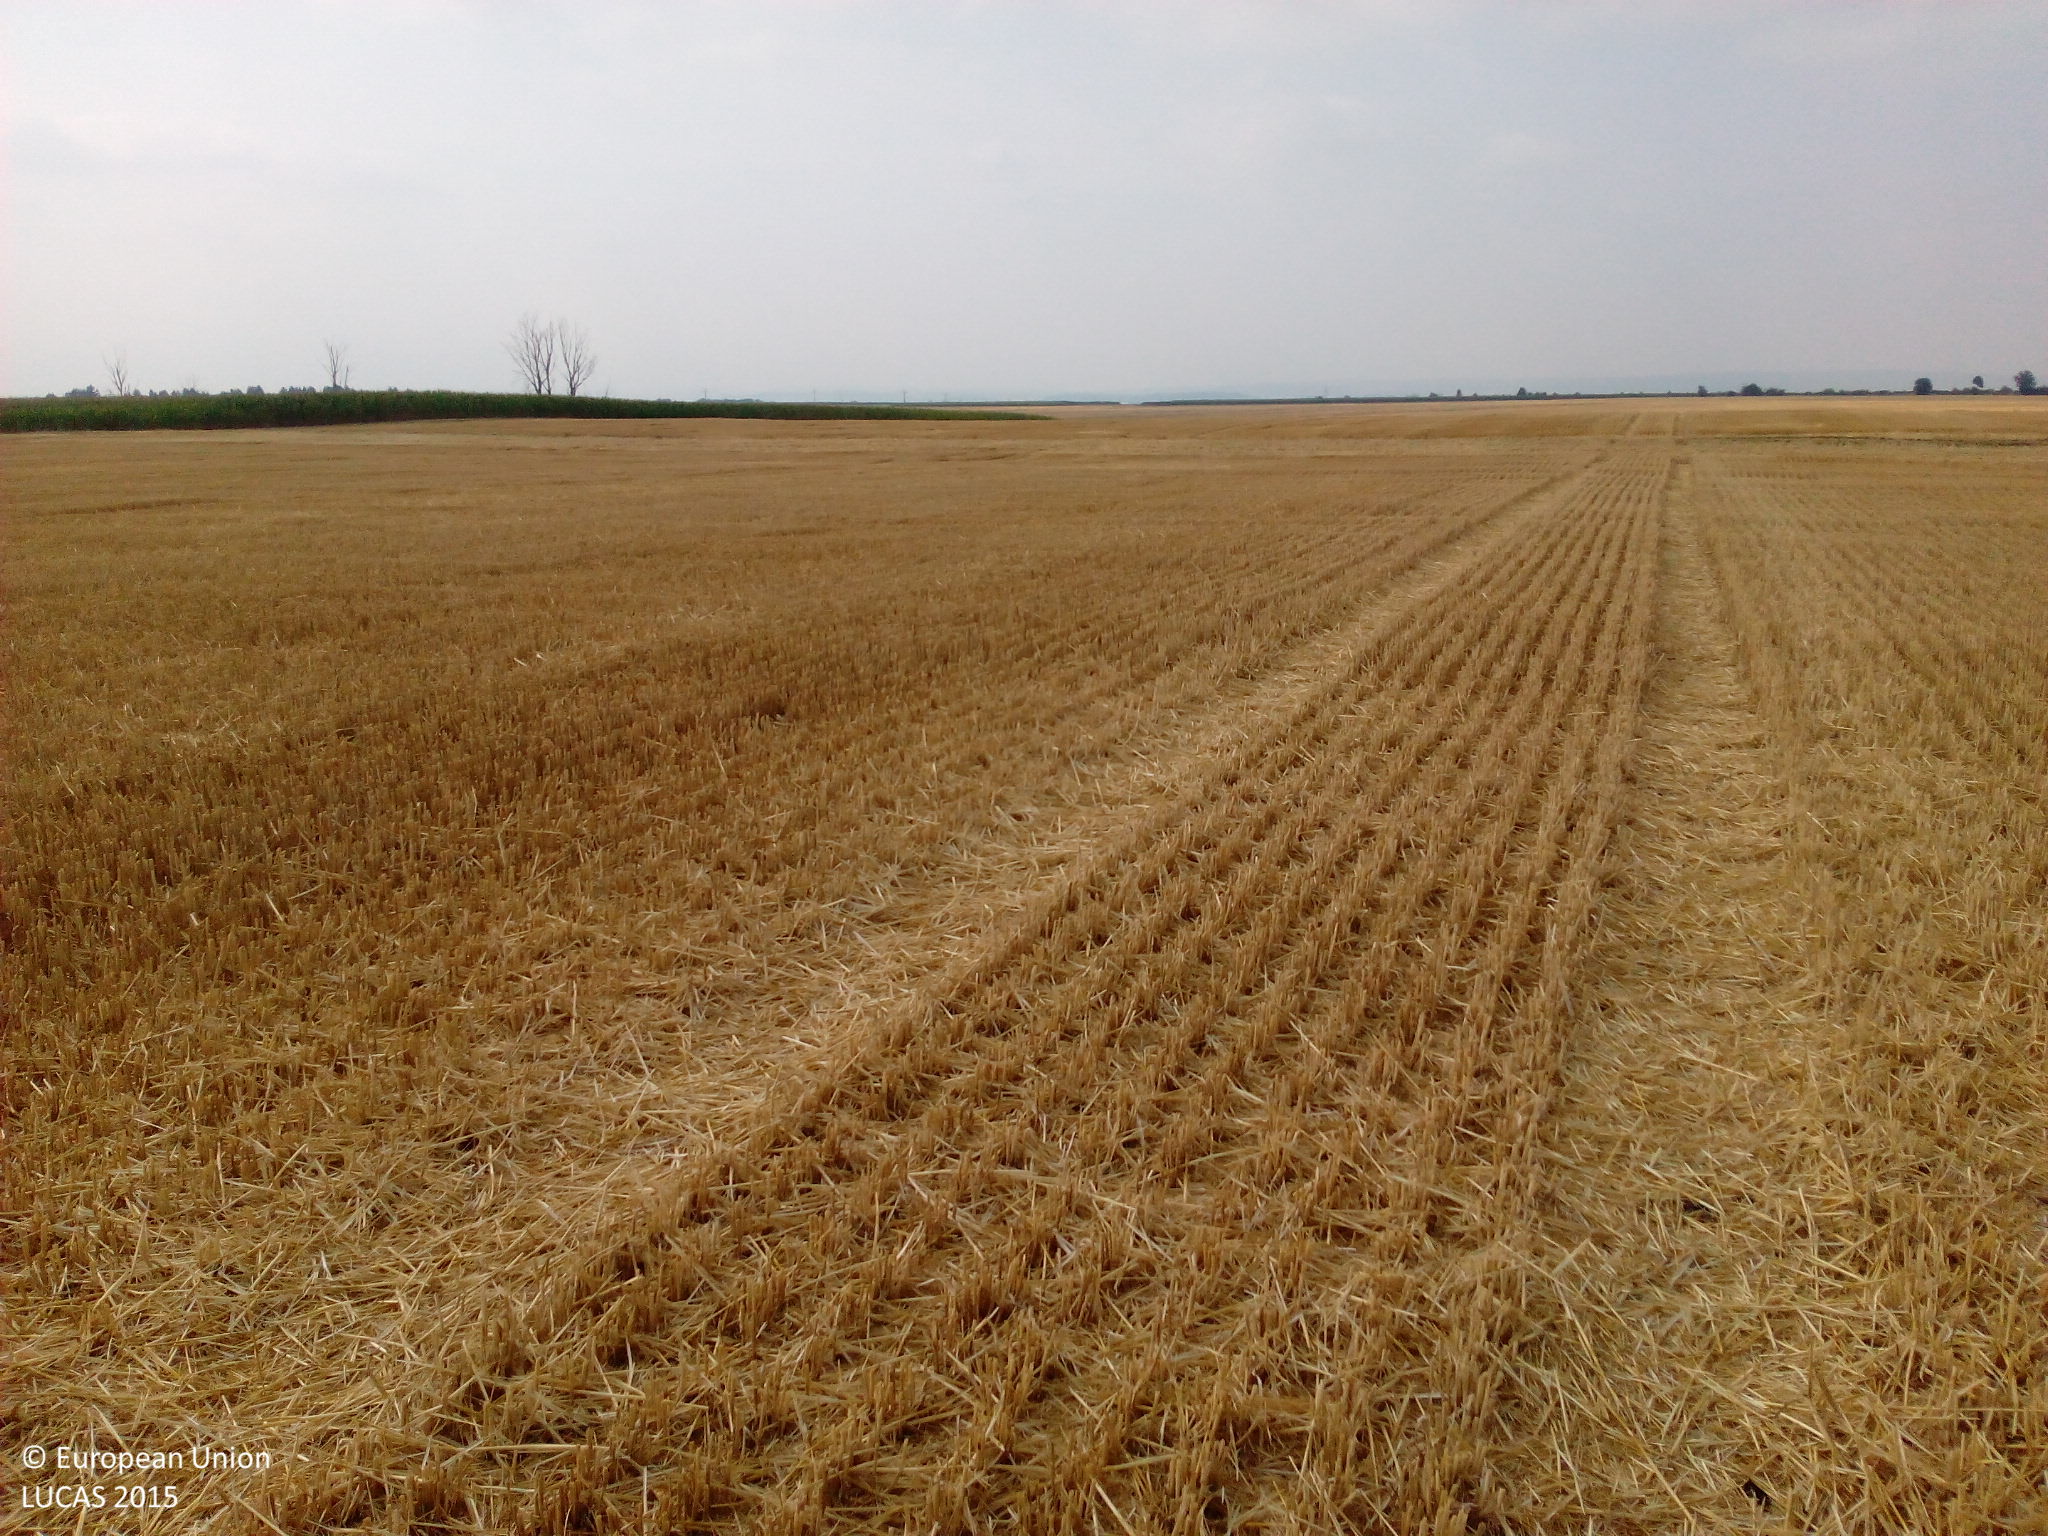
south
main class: Cropland
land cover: Common wheat
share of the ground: 50 - 75 %
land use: Agriculture (excluding fallow land and kitchen gardens)
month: August
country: DE
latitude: 48.9060
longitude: 10.5318
